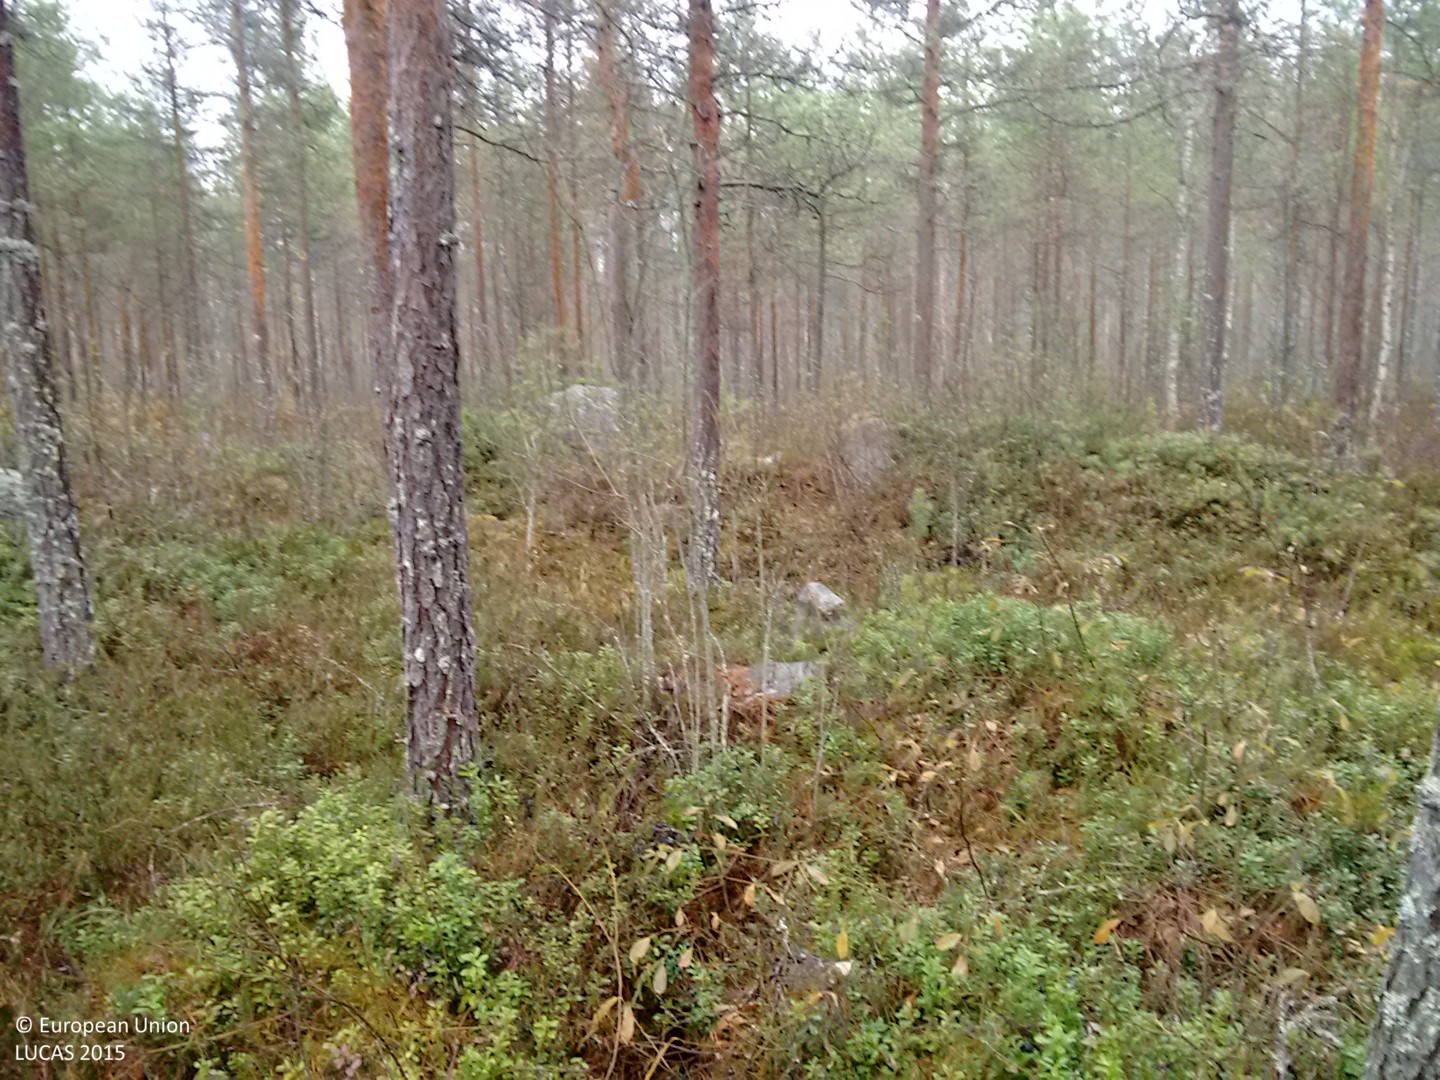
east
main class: Woodland
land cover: Pine dominated coniferous woodland
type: boreal forest
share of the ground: 50 - 75 %
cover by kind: coniferous forest trees 70 %, shrubs 25 %, lichens and mosses 5 %
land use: Forestry
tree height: > 5 m
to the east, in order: Pine dominated coniferous woodland; Ditches and canals; Pine dominated coniferous woodland; Ditches and canals; Pine dominated coniferous woodland; Ditches and canals; Pine dominated coniferous woodland; Ditches and canals; Pine dominated coniferous woodland
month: October
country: FI
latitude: 64.6550
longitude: 24.8346
